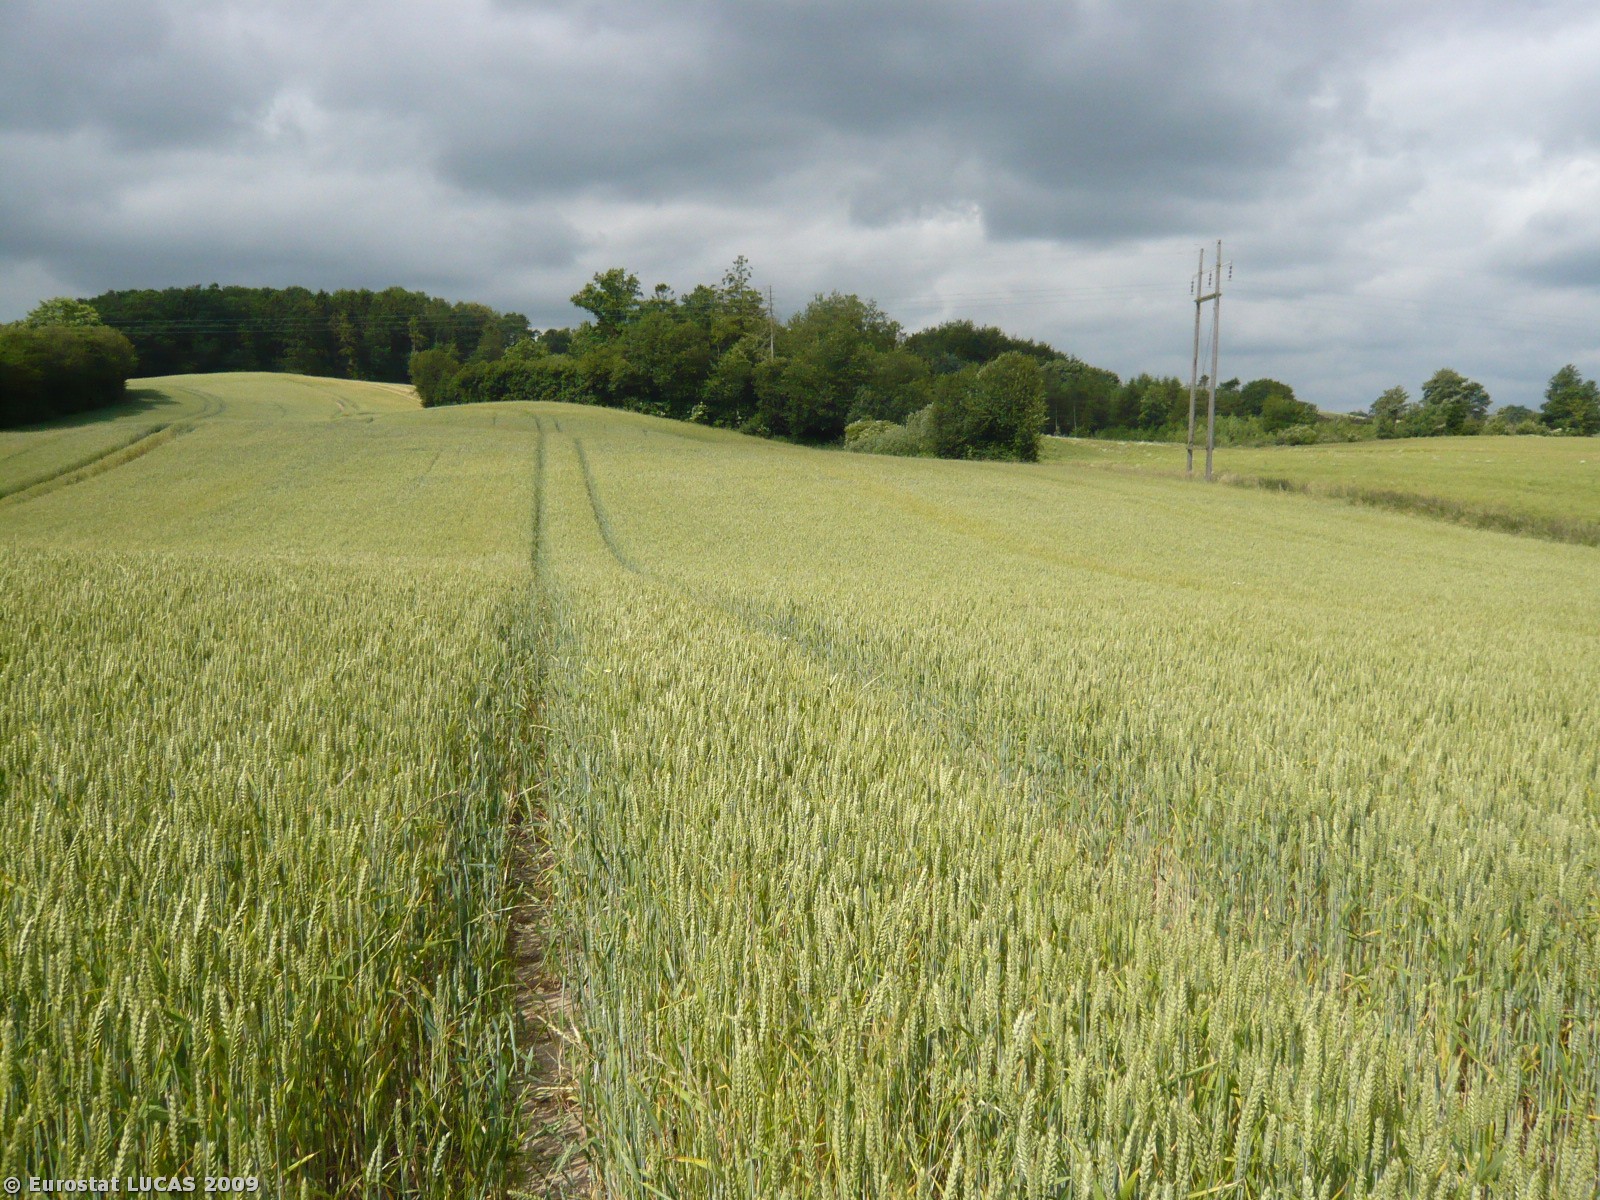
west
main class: Cropland
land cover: Common wheat
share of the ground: > 75 %
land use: Agriculture (excluding fallow land and kitchen gardens)
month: June
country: DK
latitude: 55.2709
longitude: 10.1730
